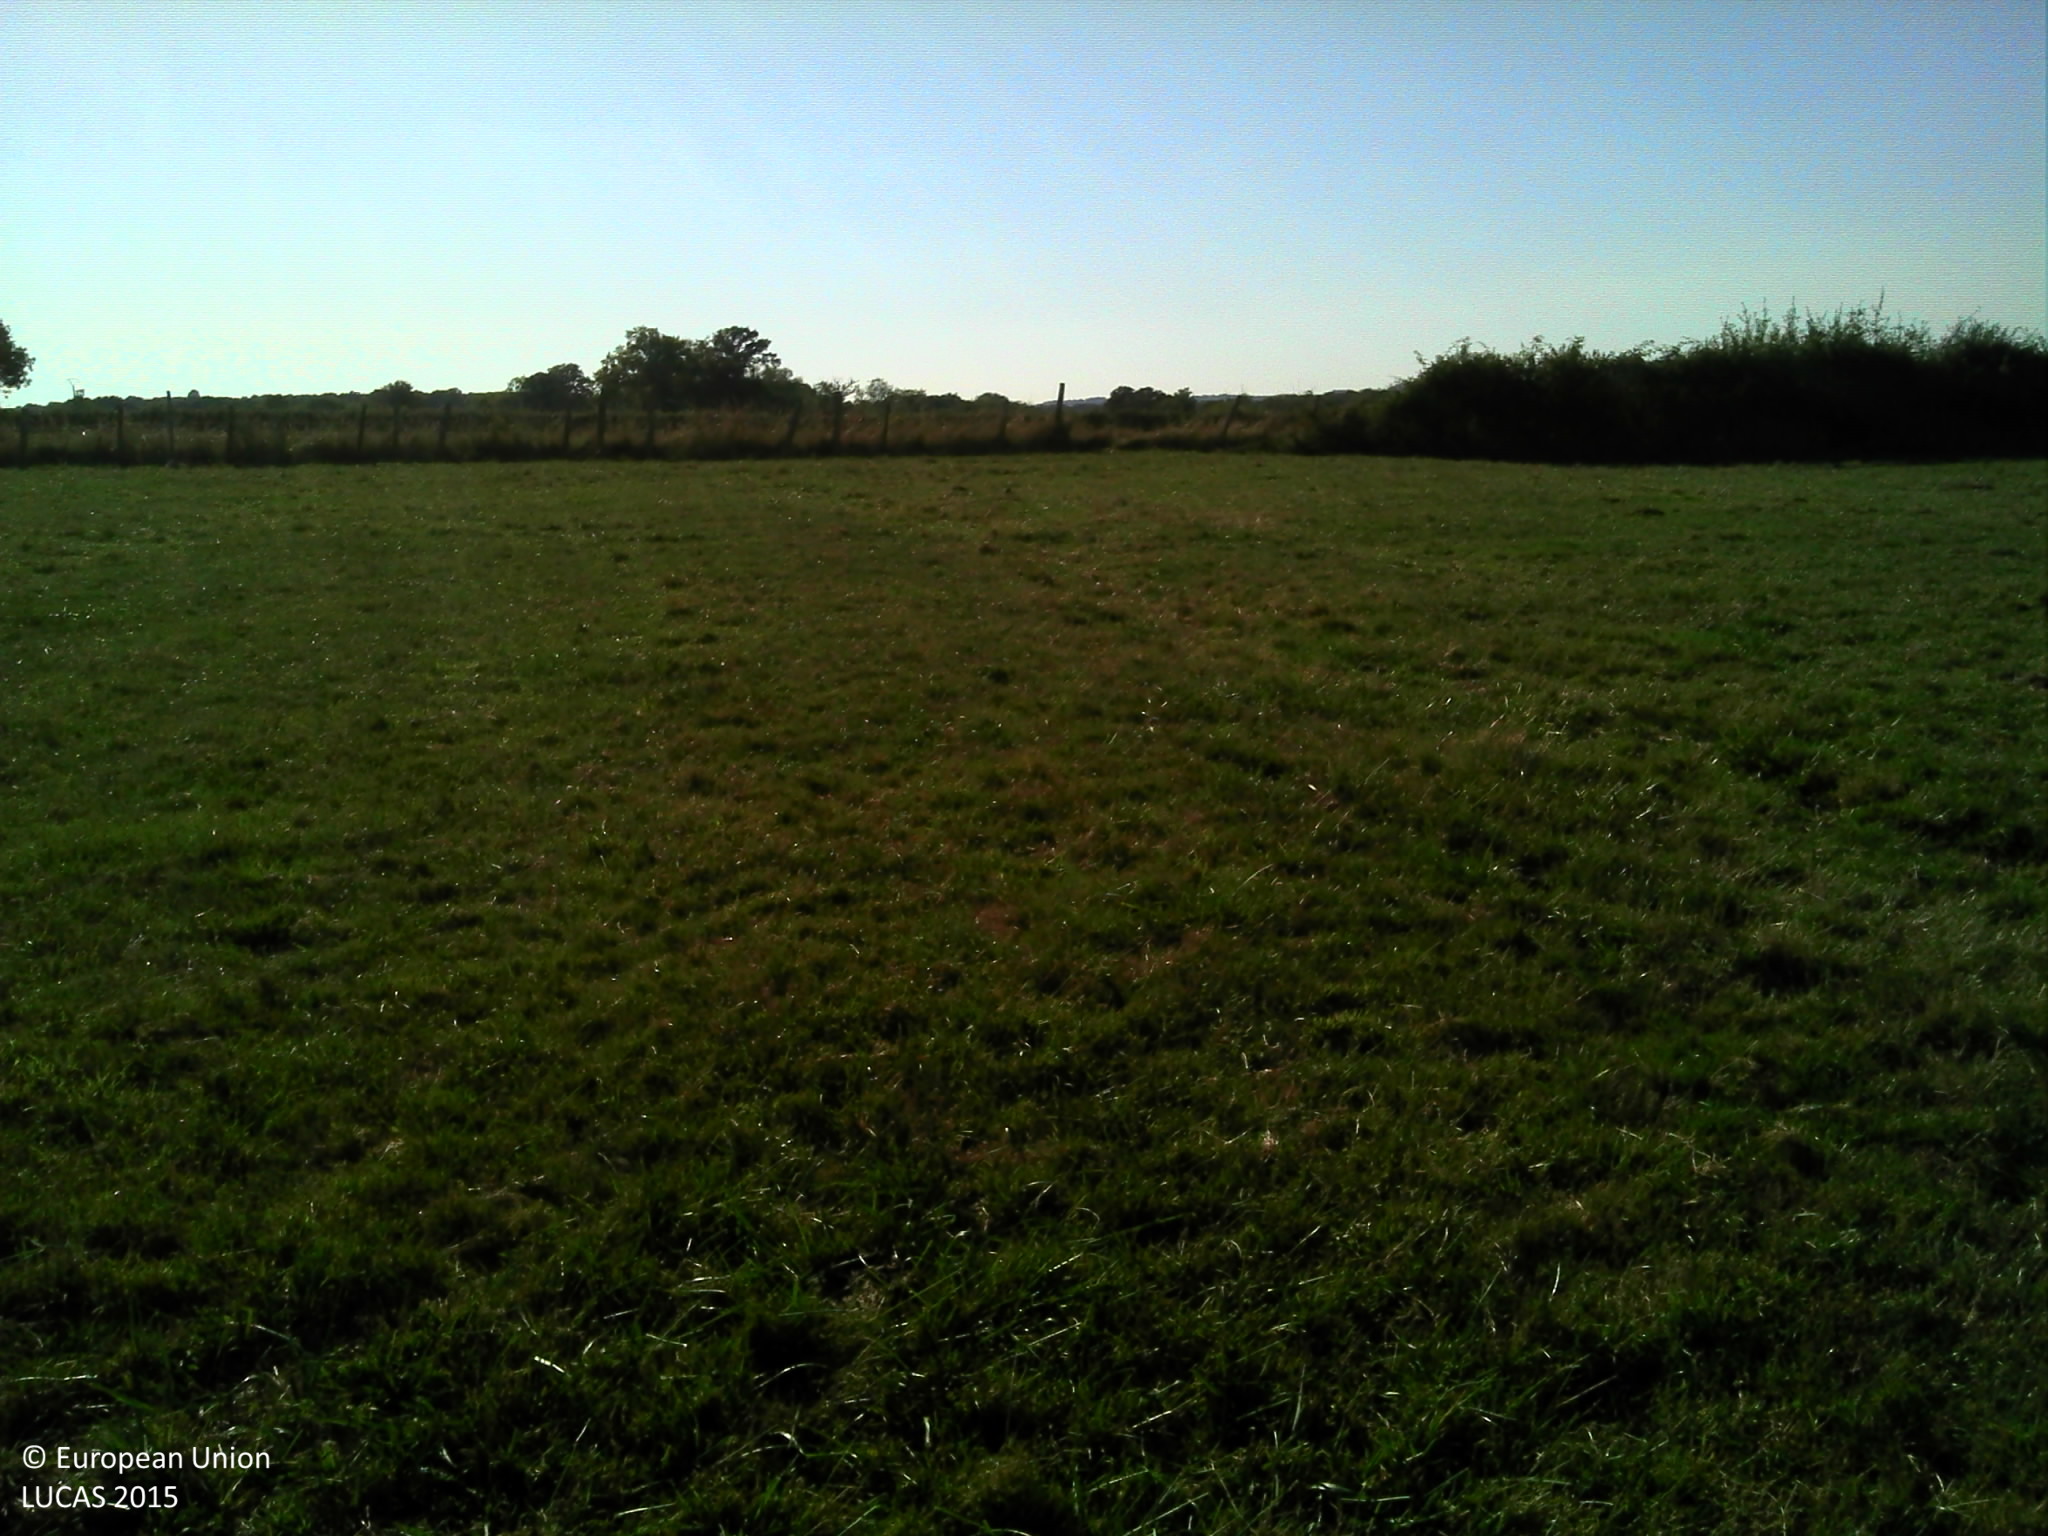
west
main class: Grassland
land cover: Grassland without tree/shrub cover
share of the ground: > 75 %
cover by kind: herbaceous plants 100 %
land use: Agriculture (excluding fallow land and kitchen gardens)
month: September
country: FR
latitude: 47.5169
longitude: 4.3017
